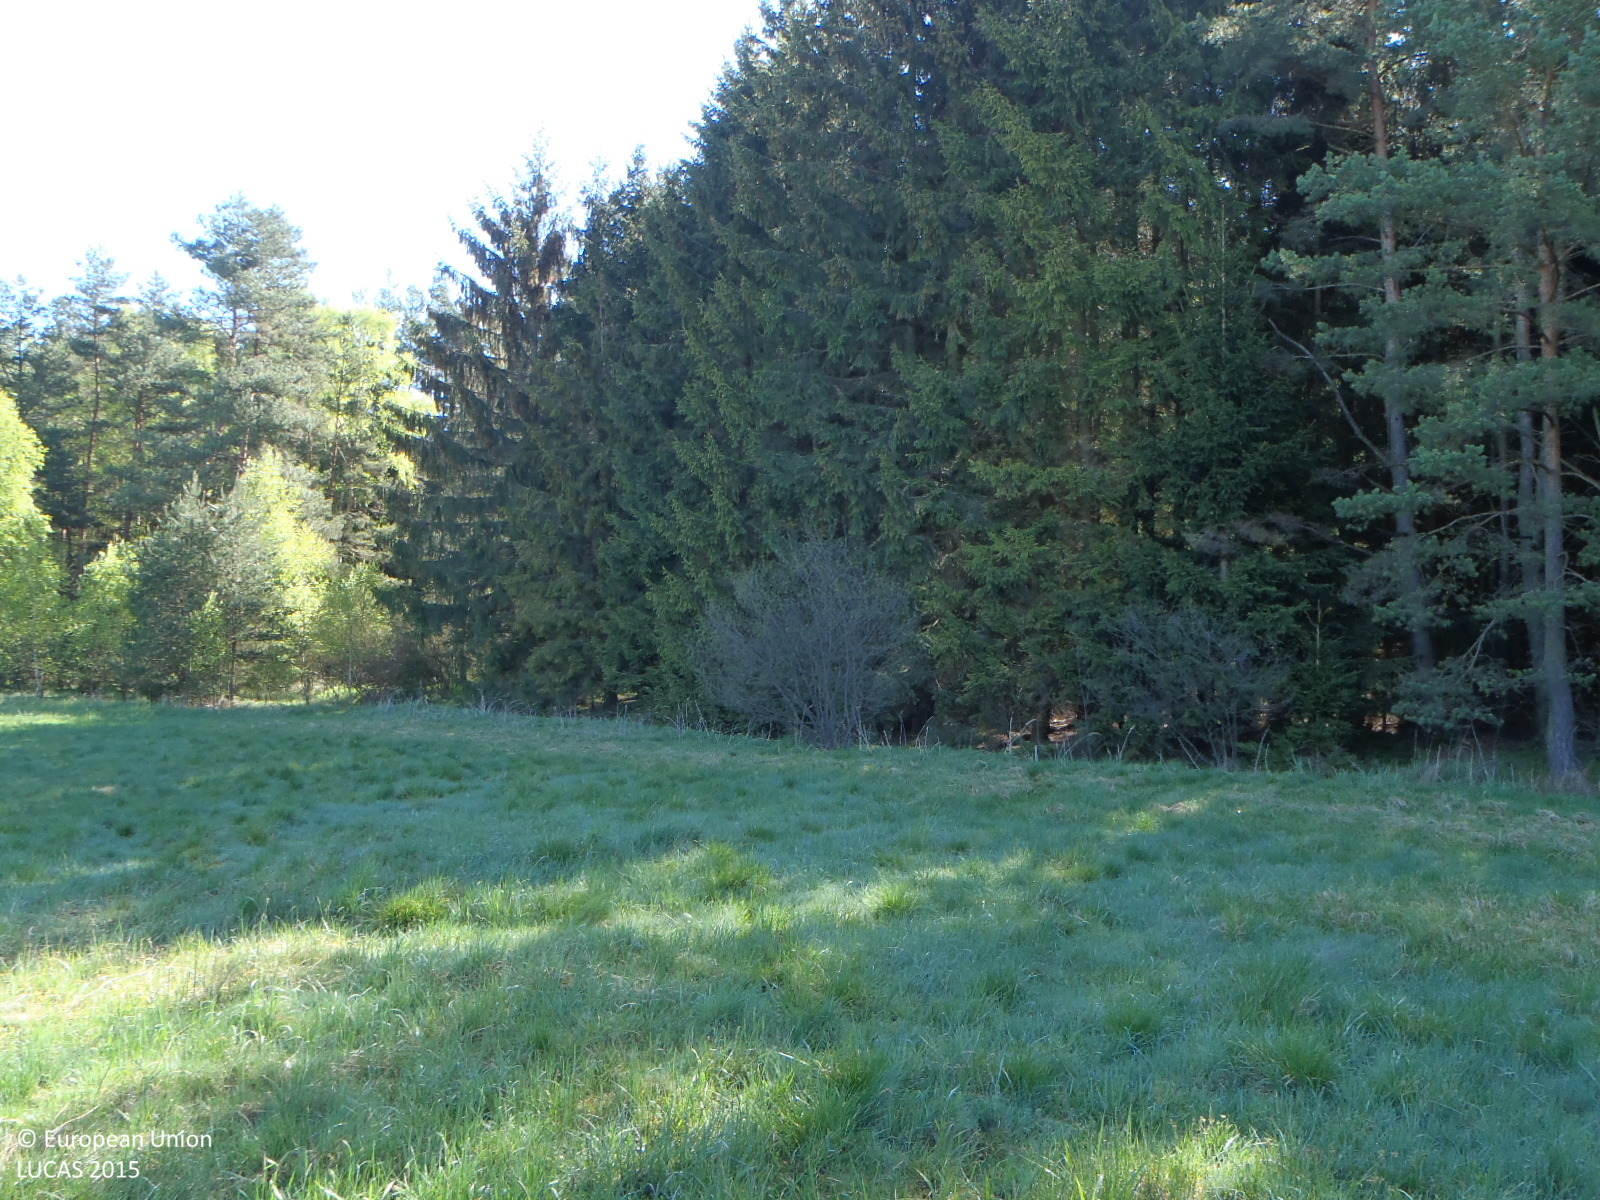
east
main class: Grassland
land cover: Grassland without tree/shrub cover
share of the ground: > 75 %
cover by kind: herbaceous plants 100 %
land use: Agriculture (excluding fallow land and kitchen gardens)
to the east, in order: Grassland without tree/shrub cover; Groves; Ditches and canals; Other coniferous woodland; Other mixed woodland; Spruce dominated coniferous woodland; Tracks; Spruce dominated coniferous woodland
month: May
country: CZ
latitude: 49.0990
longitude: 15.0562
